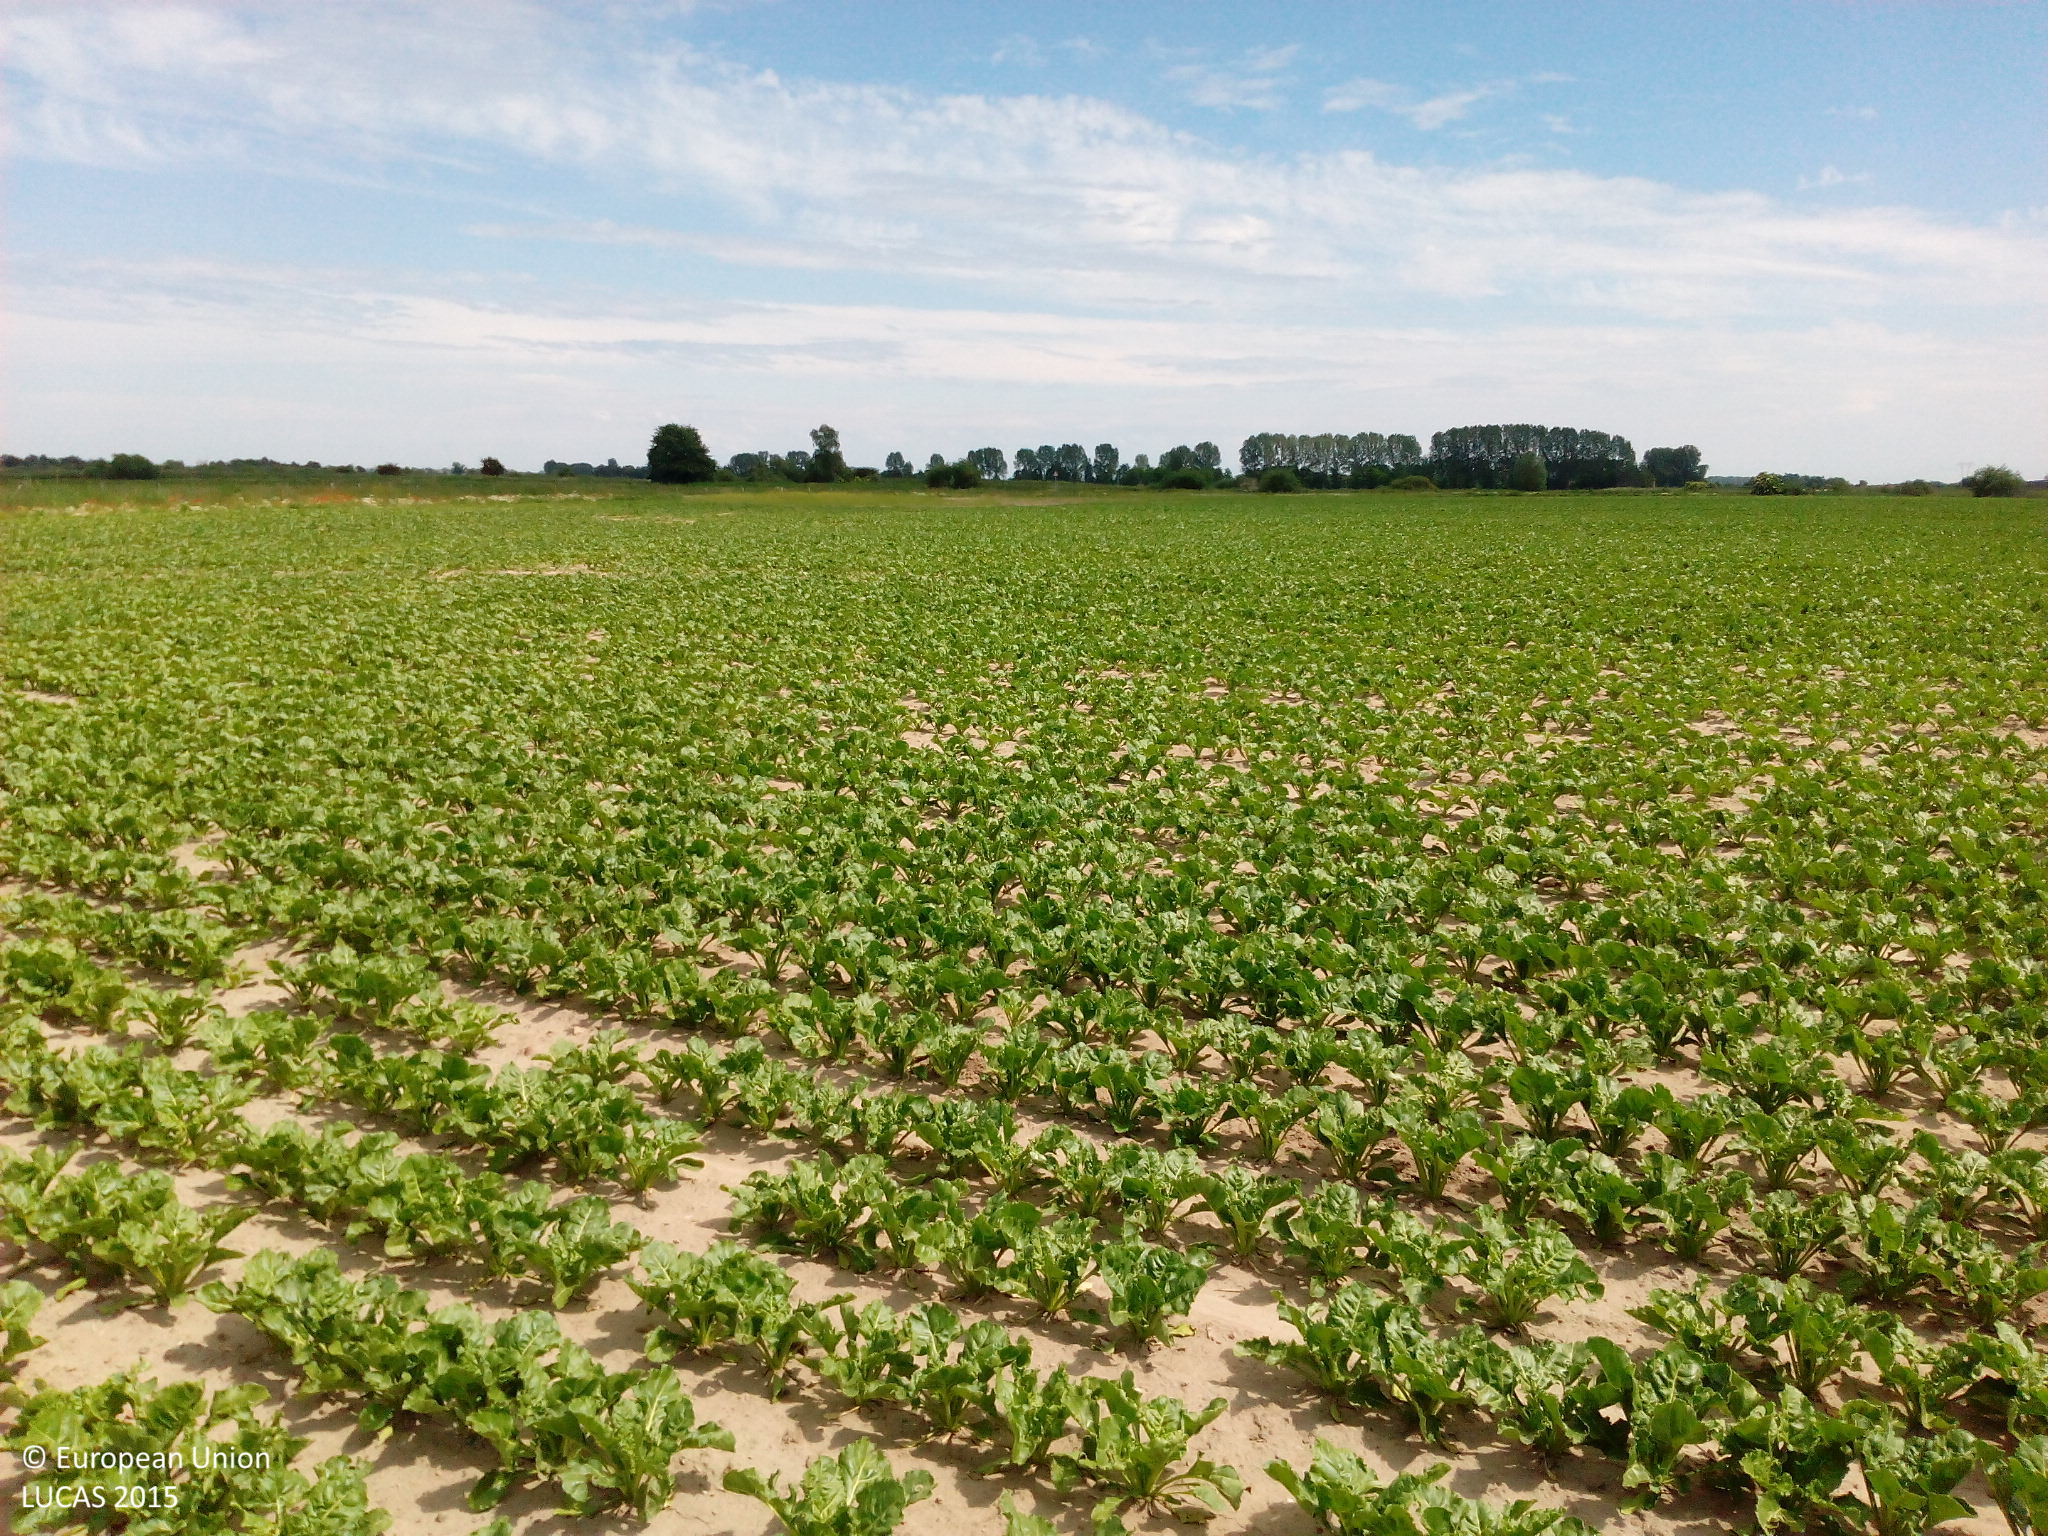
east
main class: Cropland
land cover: Sugar beet
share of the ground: 50 - 75 %
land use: Agriculture (excluding fallow land and kitchen gardens)
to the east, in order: Sugar beet; Ditches and canals; Grass margins; Paved roads, cycling and walking lanes; Grassland without tree/shrub cover; Fences; Grassland without tree/shrub cover
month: June
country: DE
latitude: 53.8476
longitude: 13.7543
